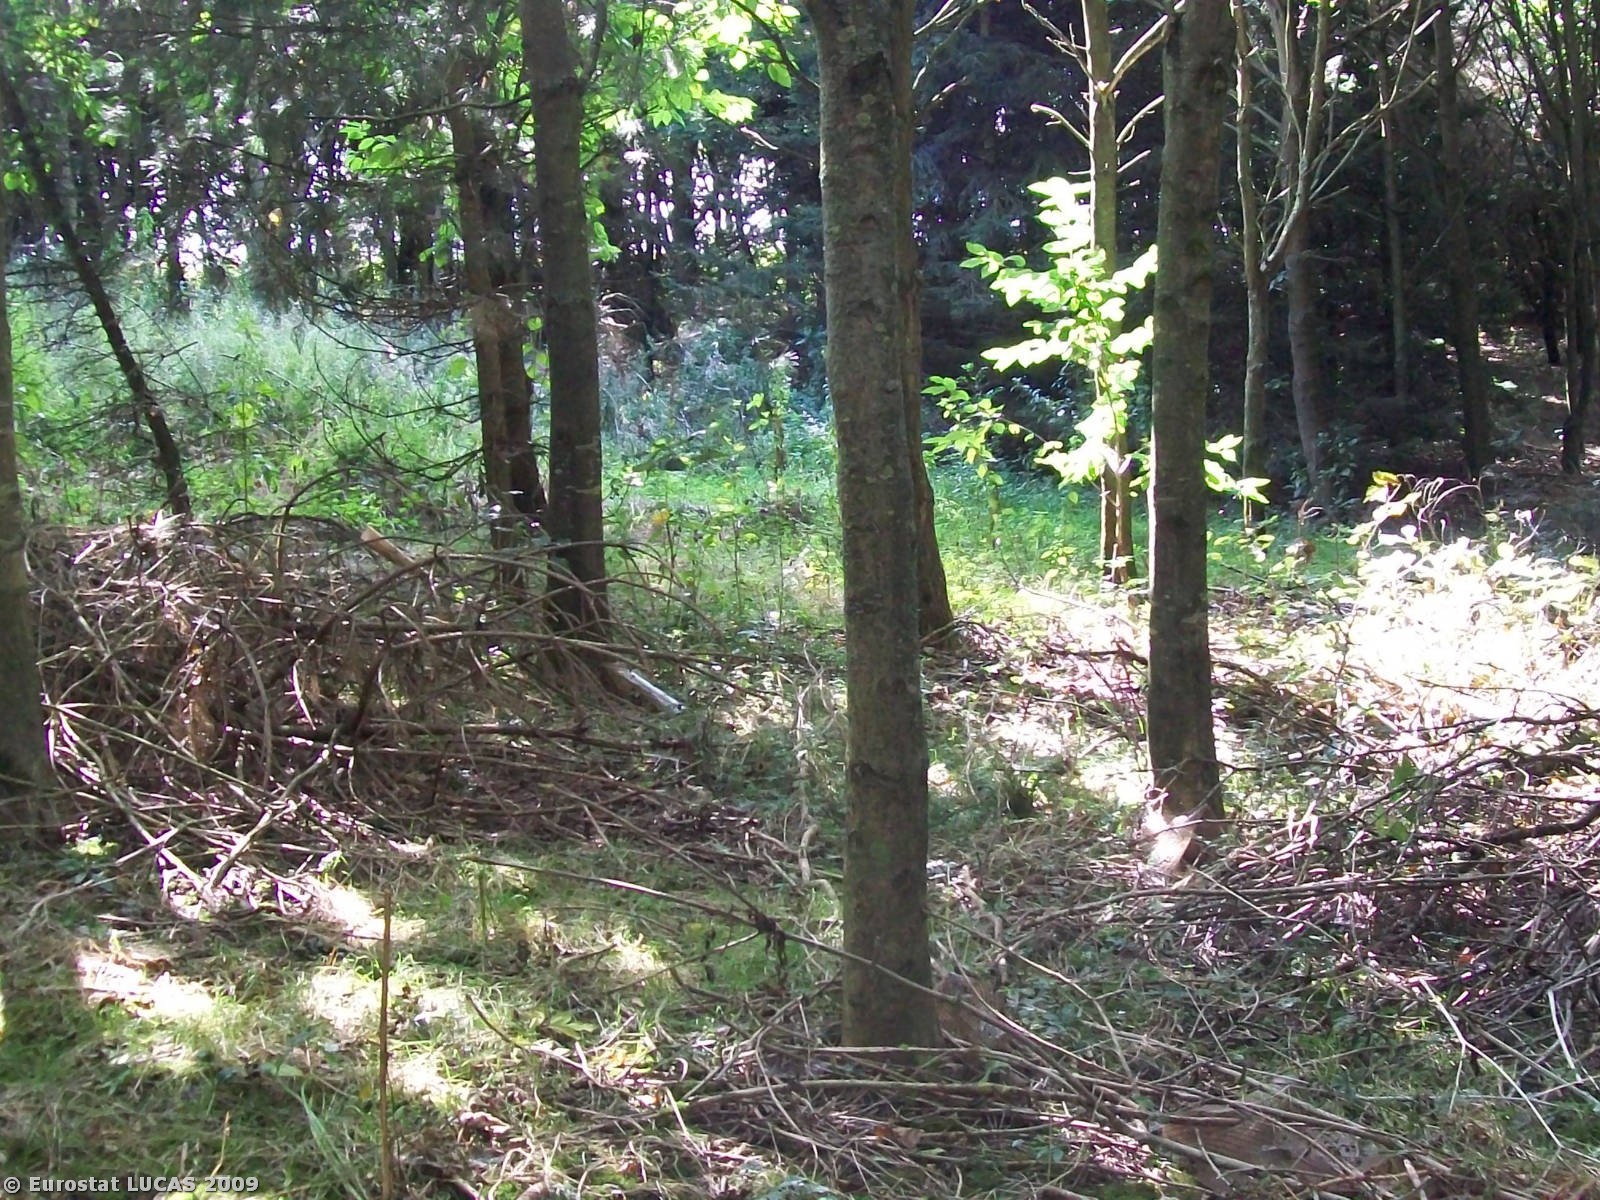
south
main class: Woodland
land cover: Broadleaved woodland
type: mesophytic deciduous forest
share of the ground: > 75 %
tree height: > 5 m
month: August
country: GB
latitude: 52.4927
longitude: -1.0767
